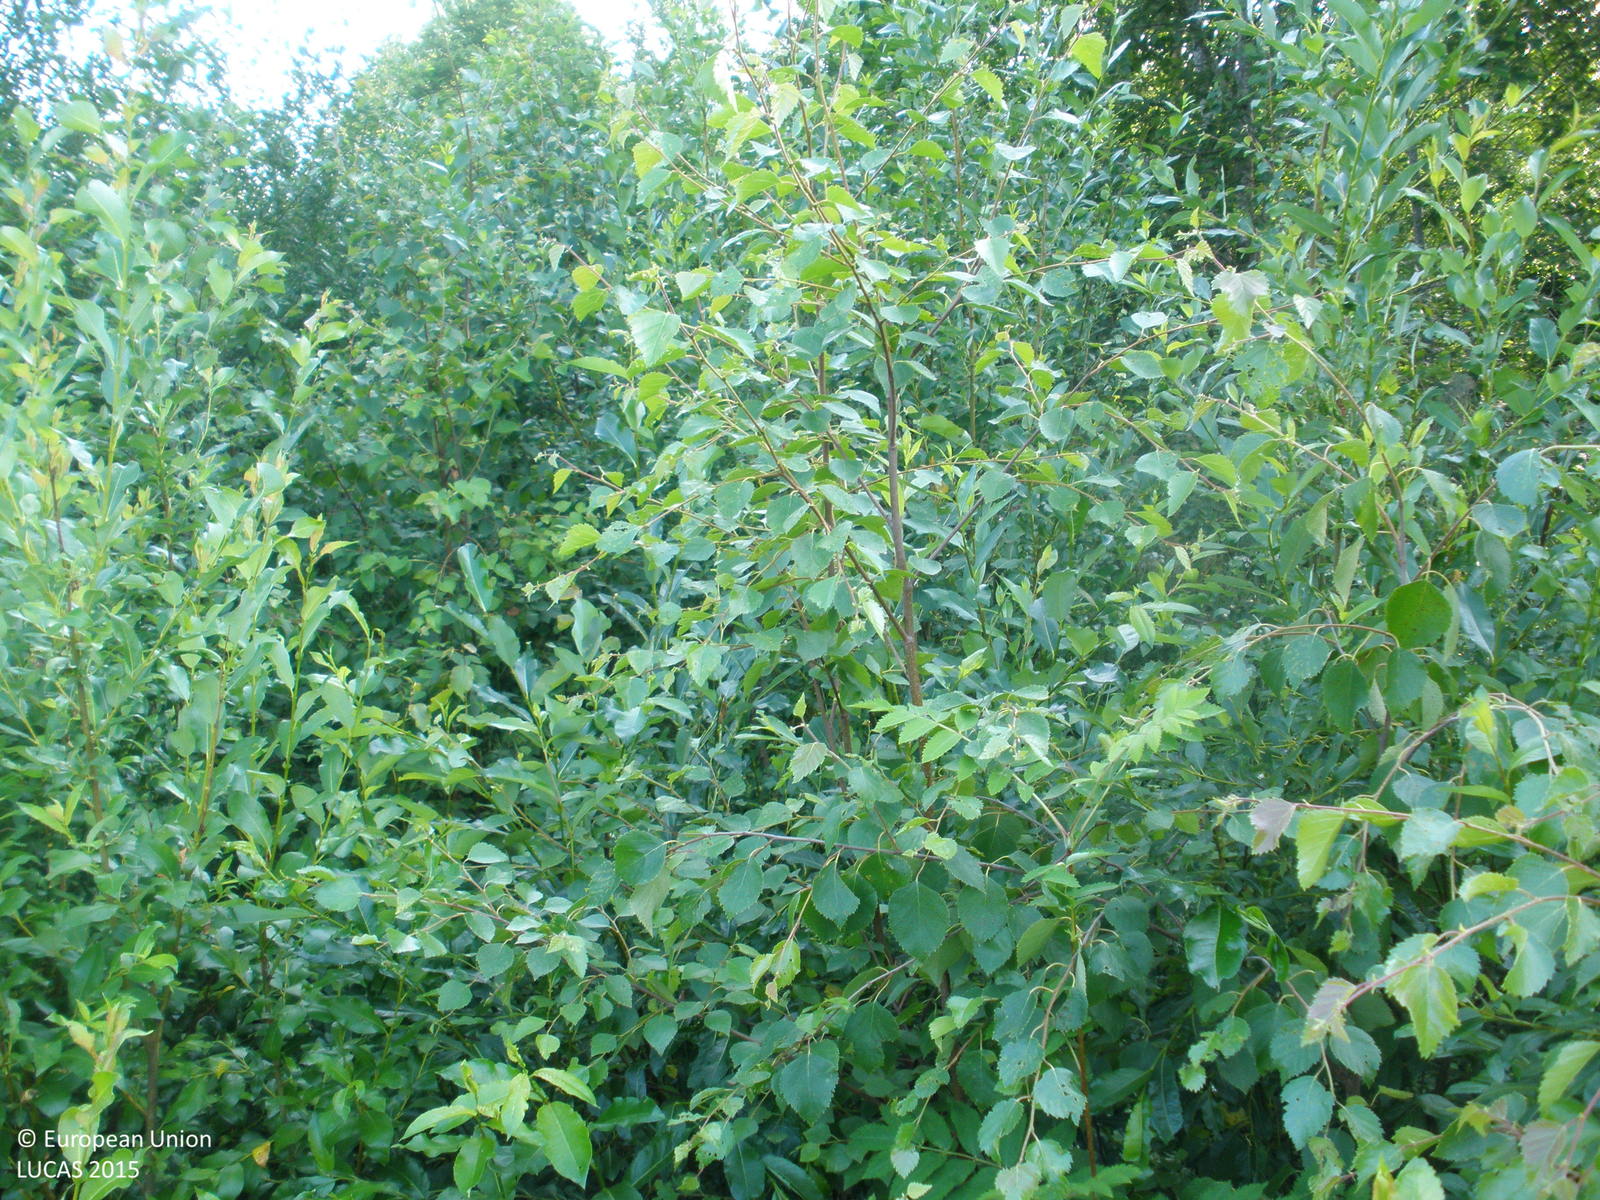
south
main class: Cropland
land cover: Oats
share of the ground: 50 - 75 %
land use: Agriculture (excluding fallow land and kitchen gardens)
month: July
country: FI
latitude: 61.4238
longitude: 23.9757
